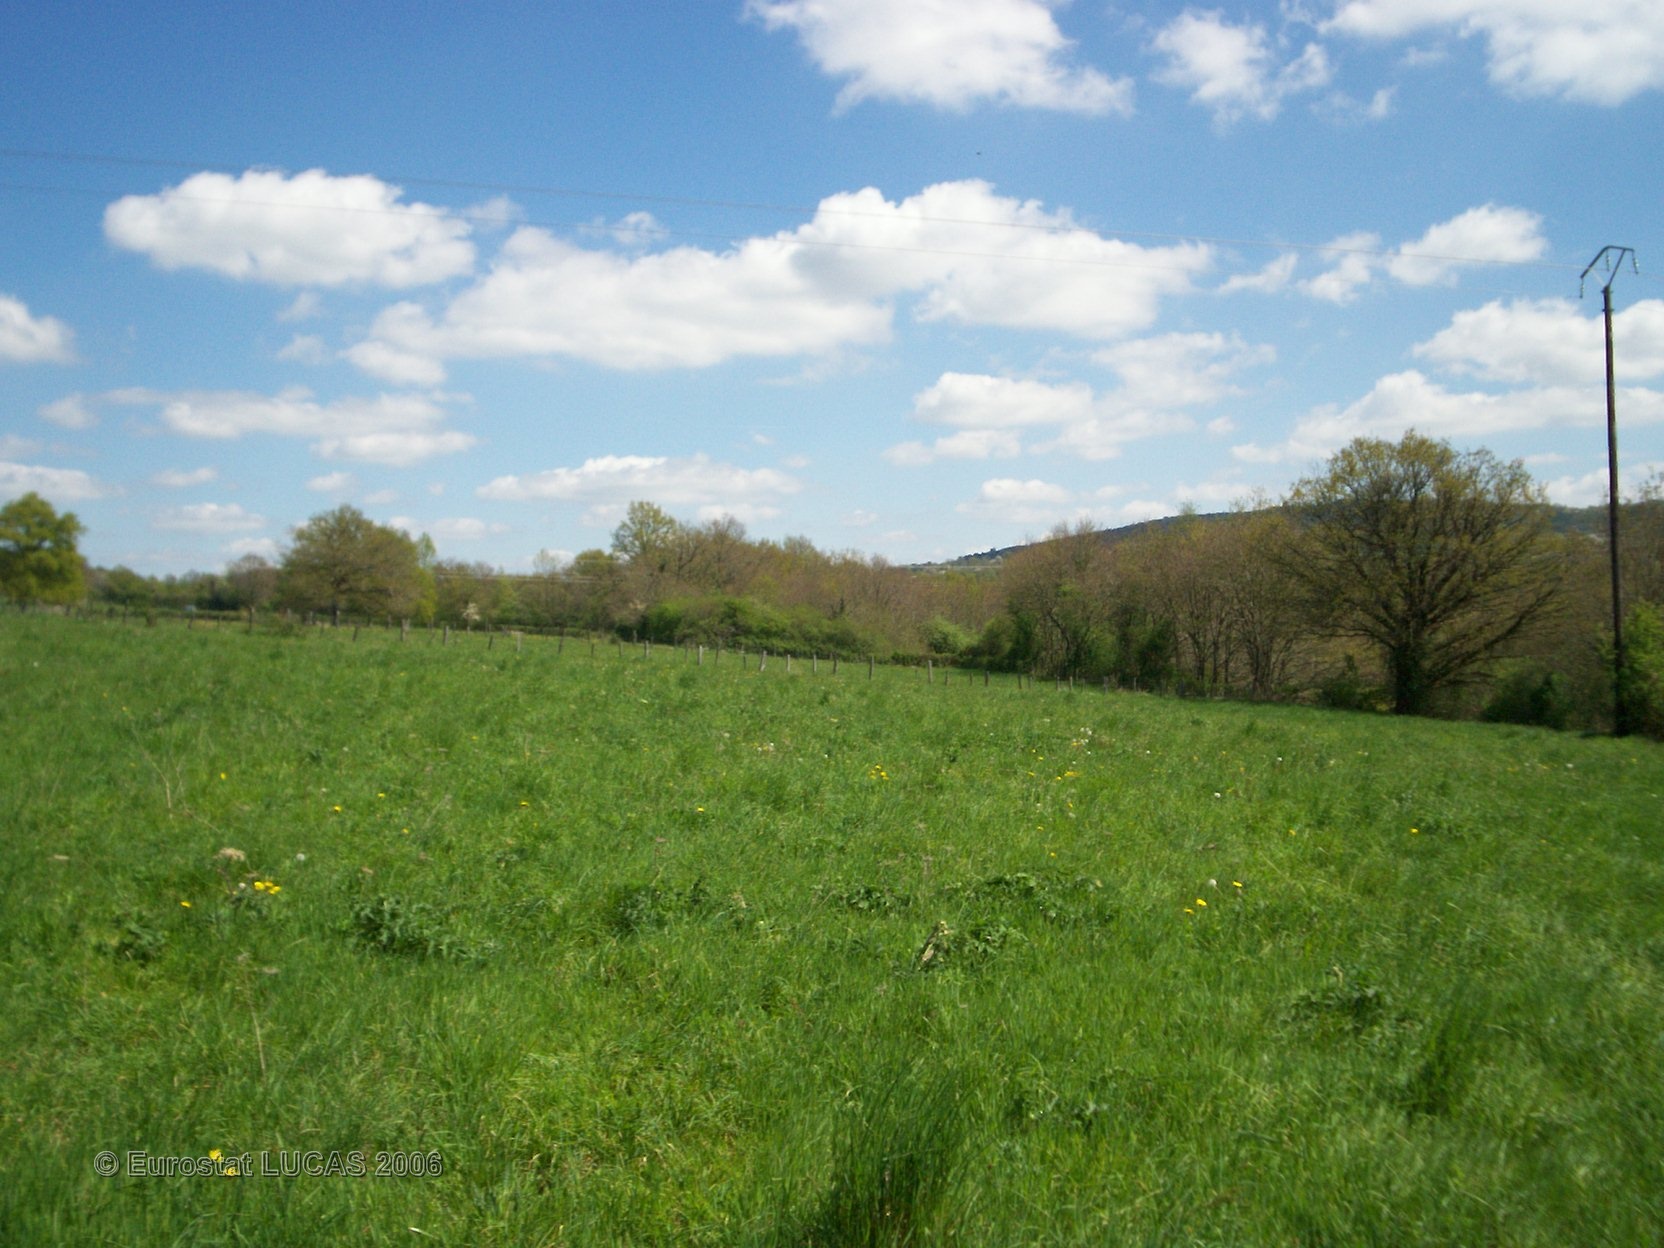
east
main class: Grassland
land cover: Grassland without tree/shrub cover
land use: Agriculture (excluding fallow land and kitchen gardens)
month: April
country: FR
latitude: 46.2954
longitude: 1.6441
